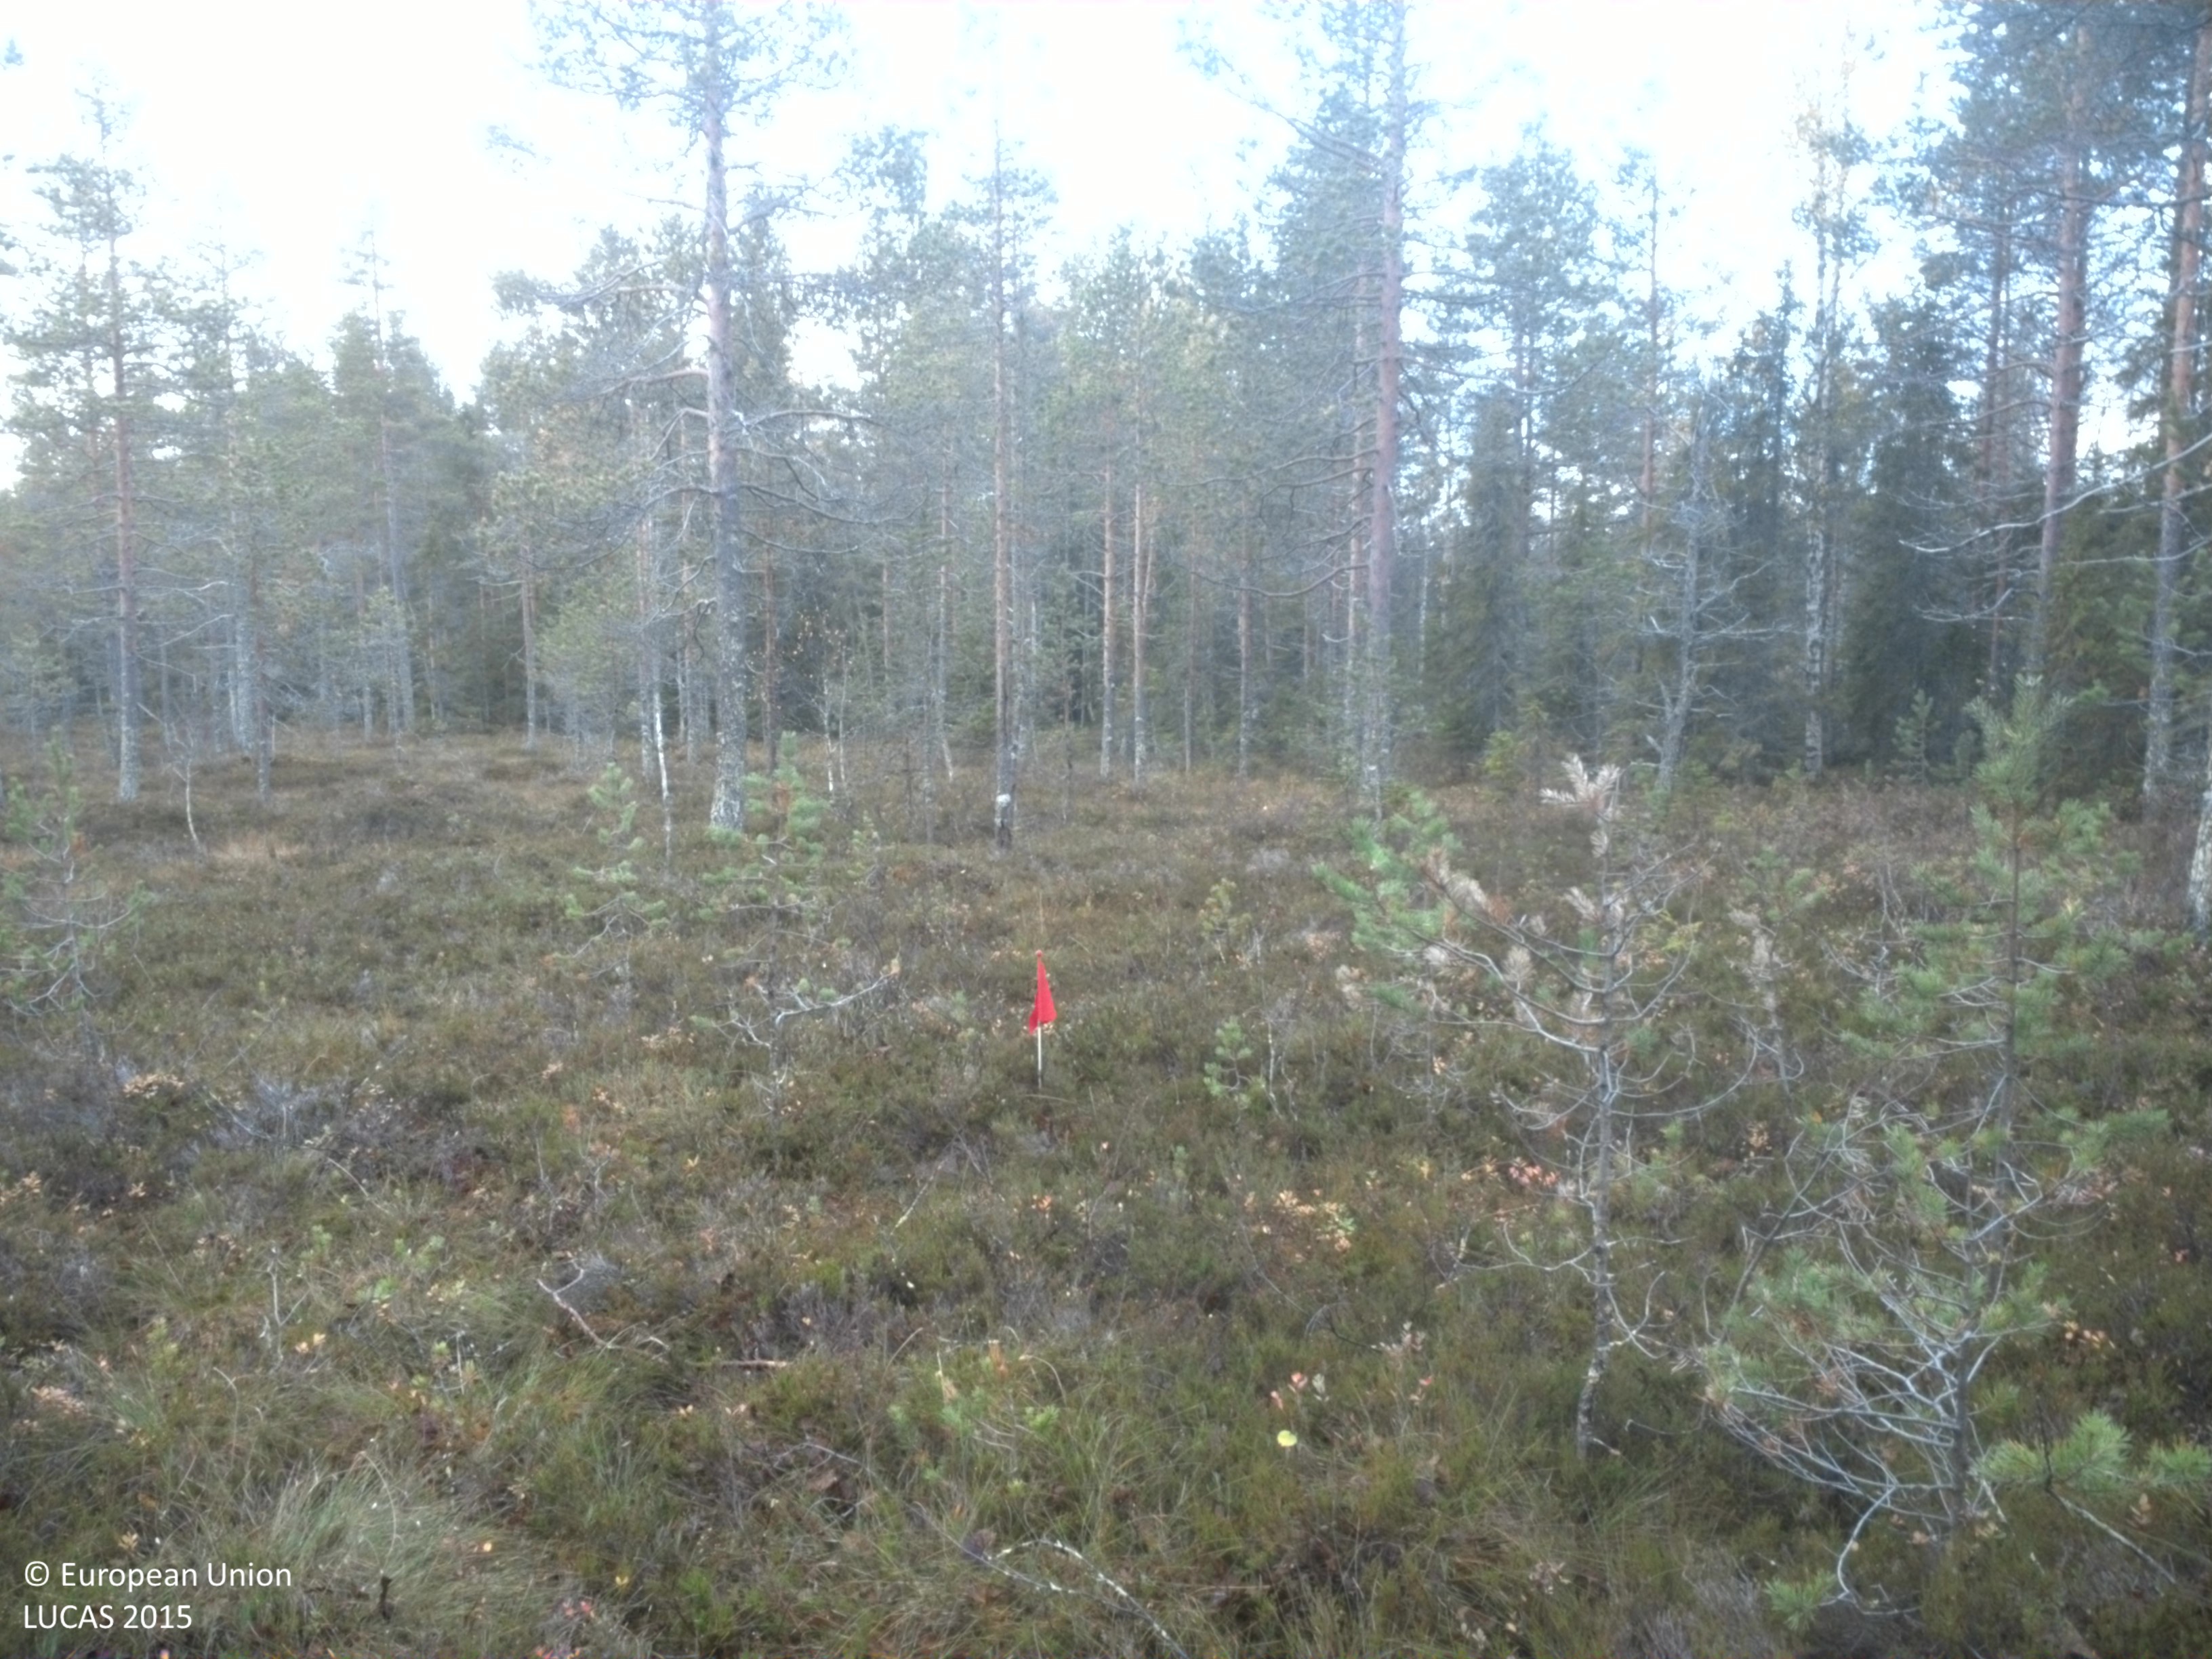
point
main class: Woodland
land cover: Pine dominated coniferous woodland
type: boreal forest
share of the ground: 25 - 50 %
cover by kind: coniferous forest trees 40 %, shrubs 30 %, lichens and mosses 25 %, herbaceous plants 5 %
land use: Semi-natural and natural areas not in use
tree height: > 5 m
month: September
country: SE
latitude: 64.2141
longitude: 19.9278
